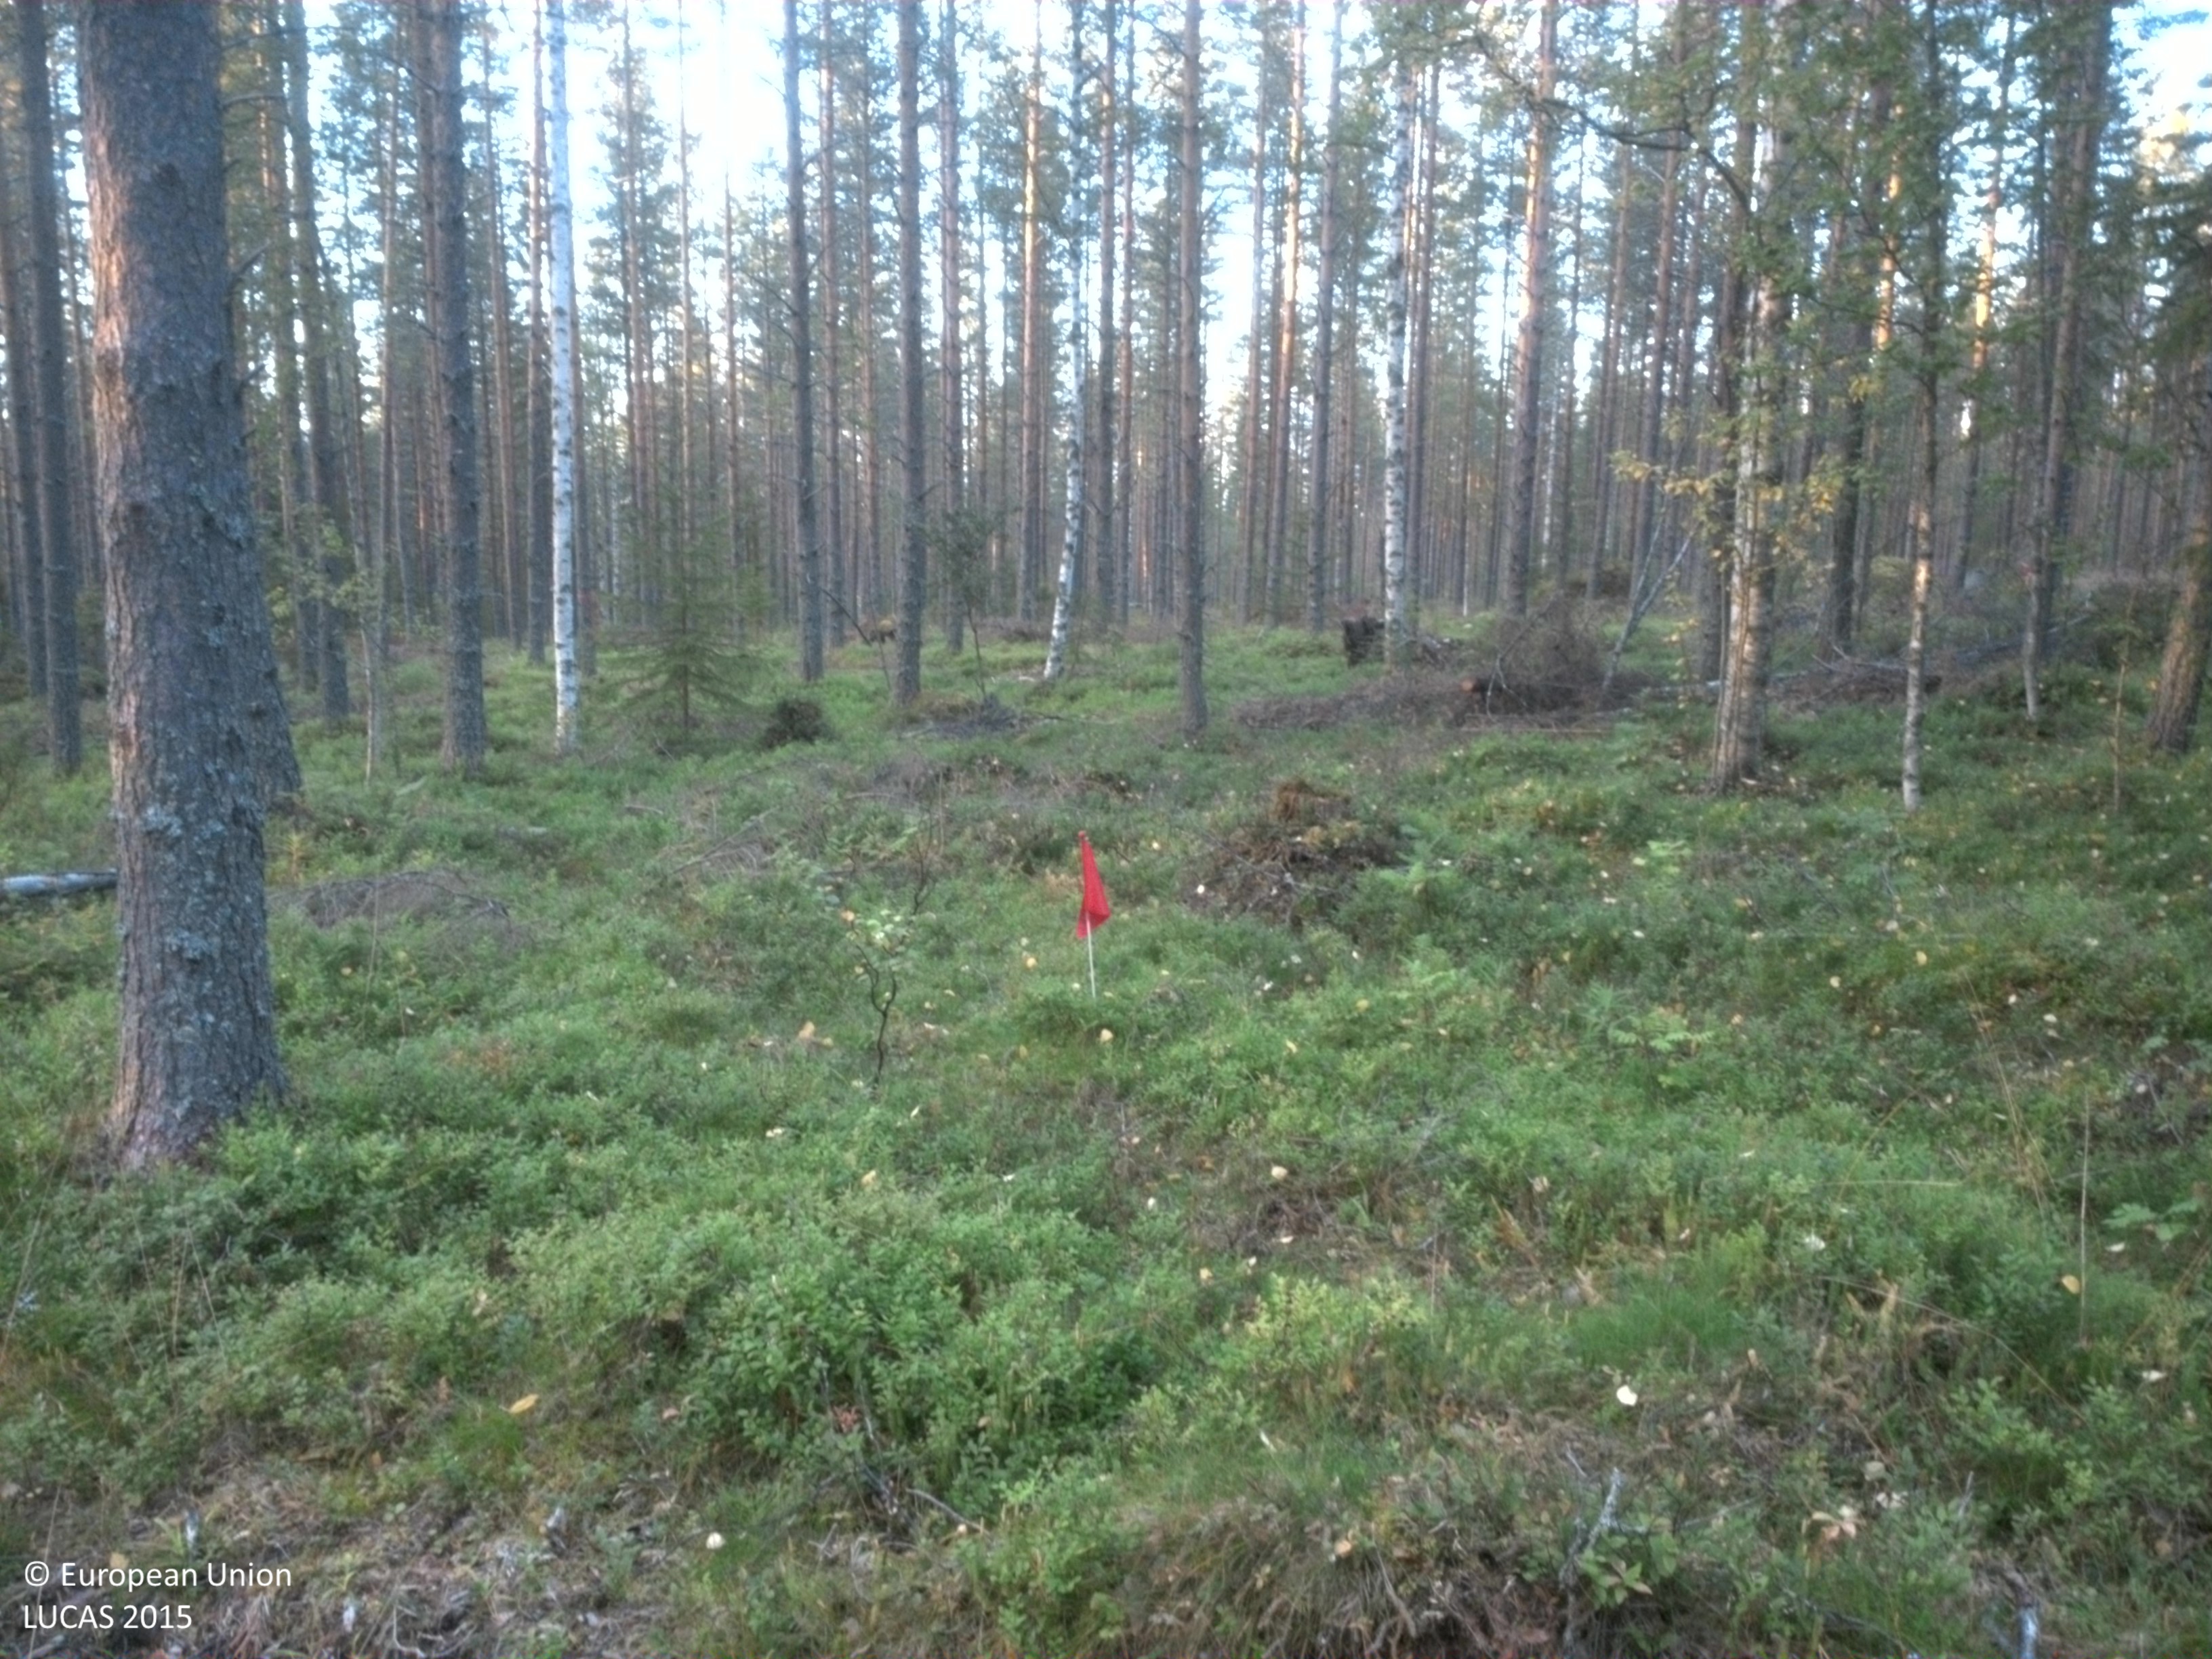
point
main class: Woodland
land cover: Pine dominated coniferous woodland
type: boreal forest
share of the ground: 25 - 50 %
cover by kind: coniferous forest trees 45 %, shrubs 45 %, broadleaved forest trees 5 %, lichens and mosses 5 %
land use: Forestry
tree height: > 5 m
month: September
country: SE
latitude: 64.3566
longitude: 19.6867
